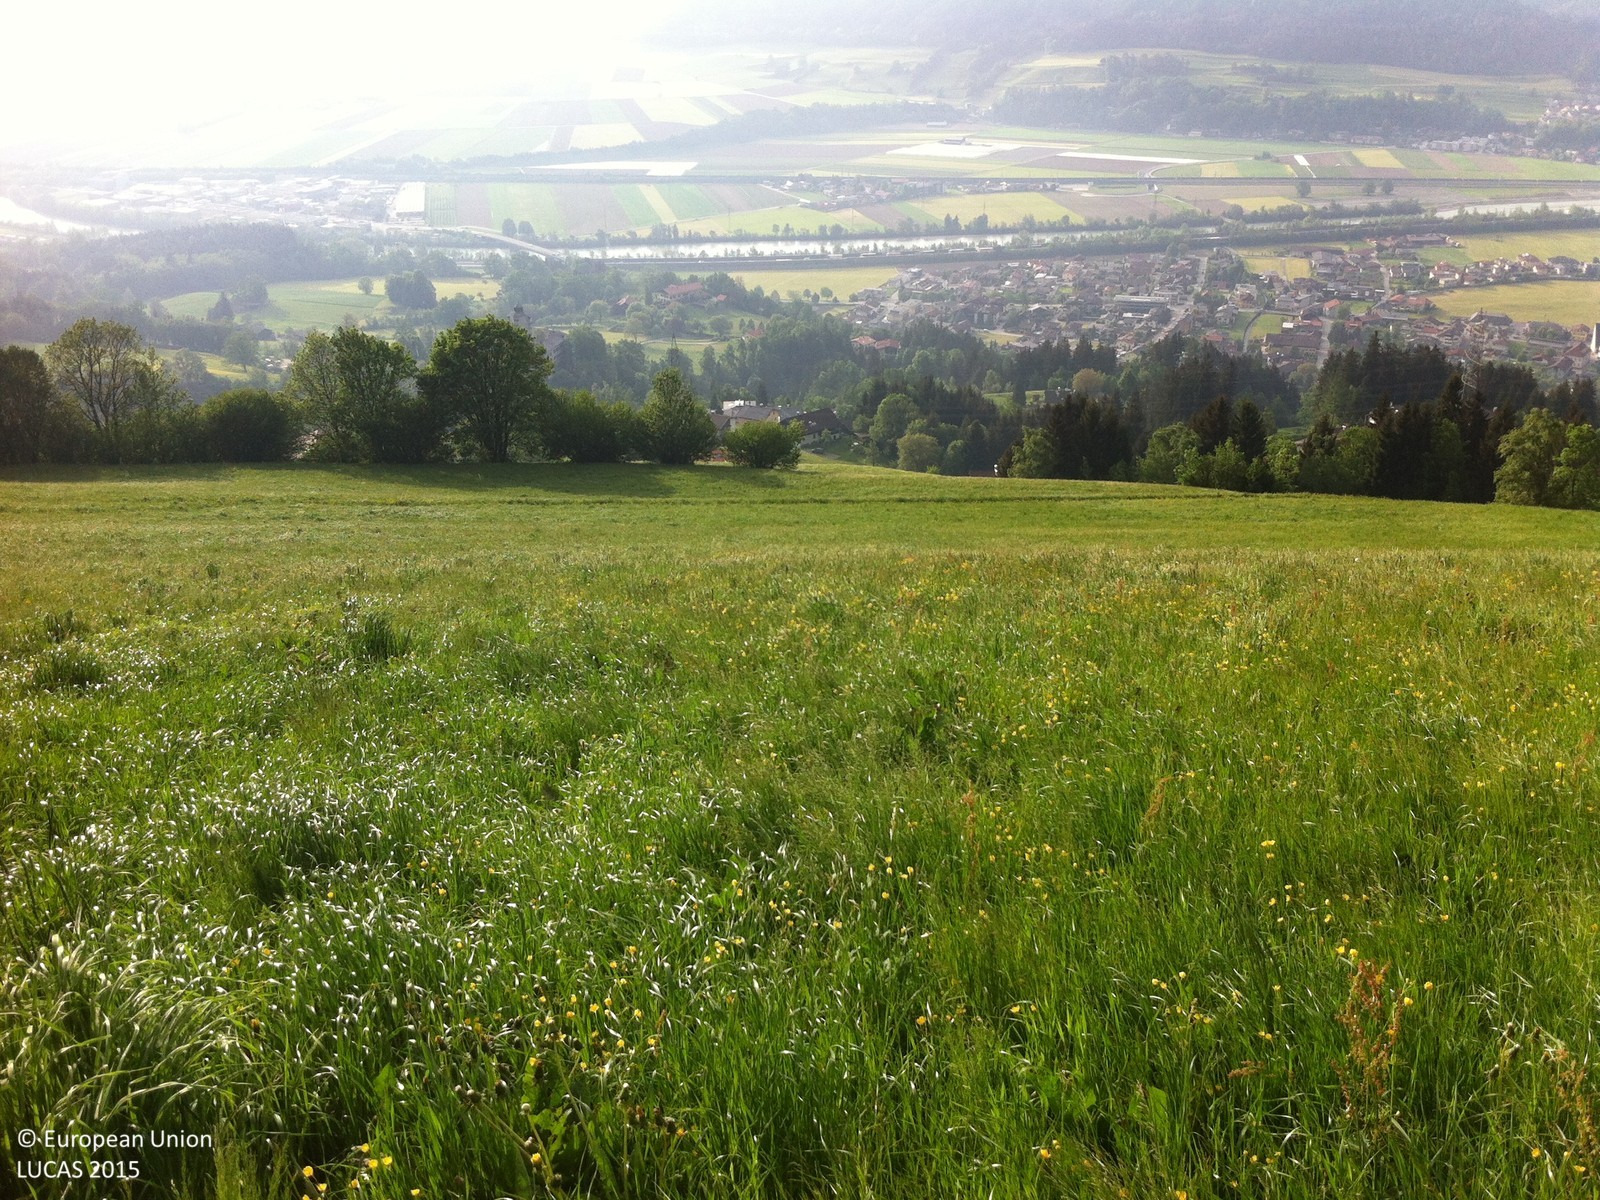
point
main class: Grassland
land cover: Grassland without tree/shrub cover
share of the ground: > 75 %
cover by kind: herbaceous plants 100 %
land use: Agriculture (excluding fallow land and kitchen gardens)
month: May
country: AT
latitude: 47.2762
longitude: 11.5717
